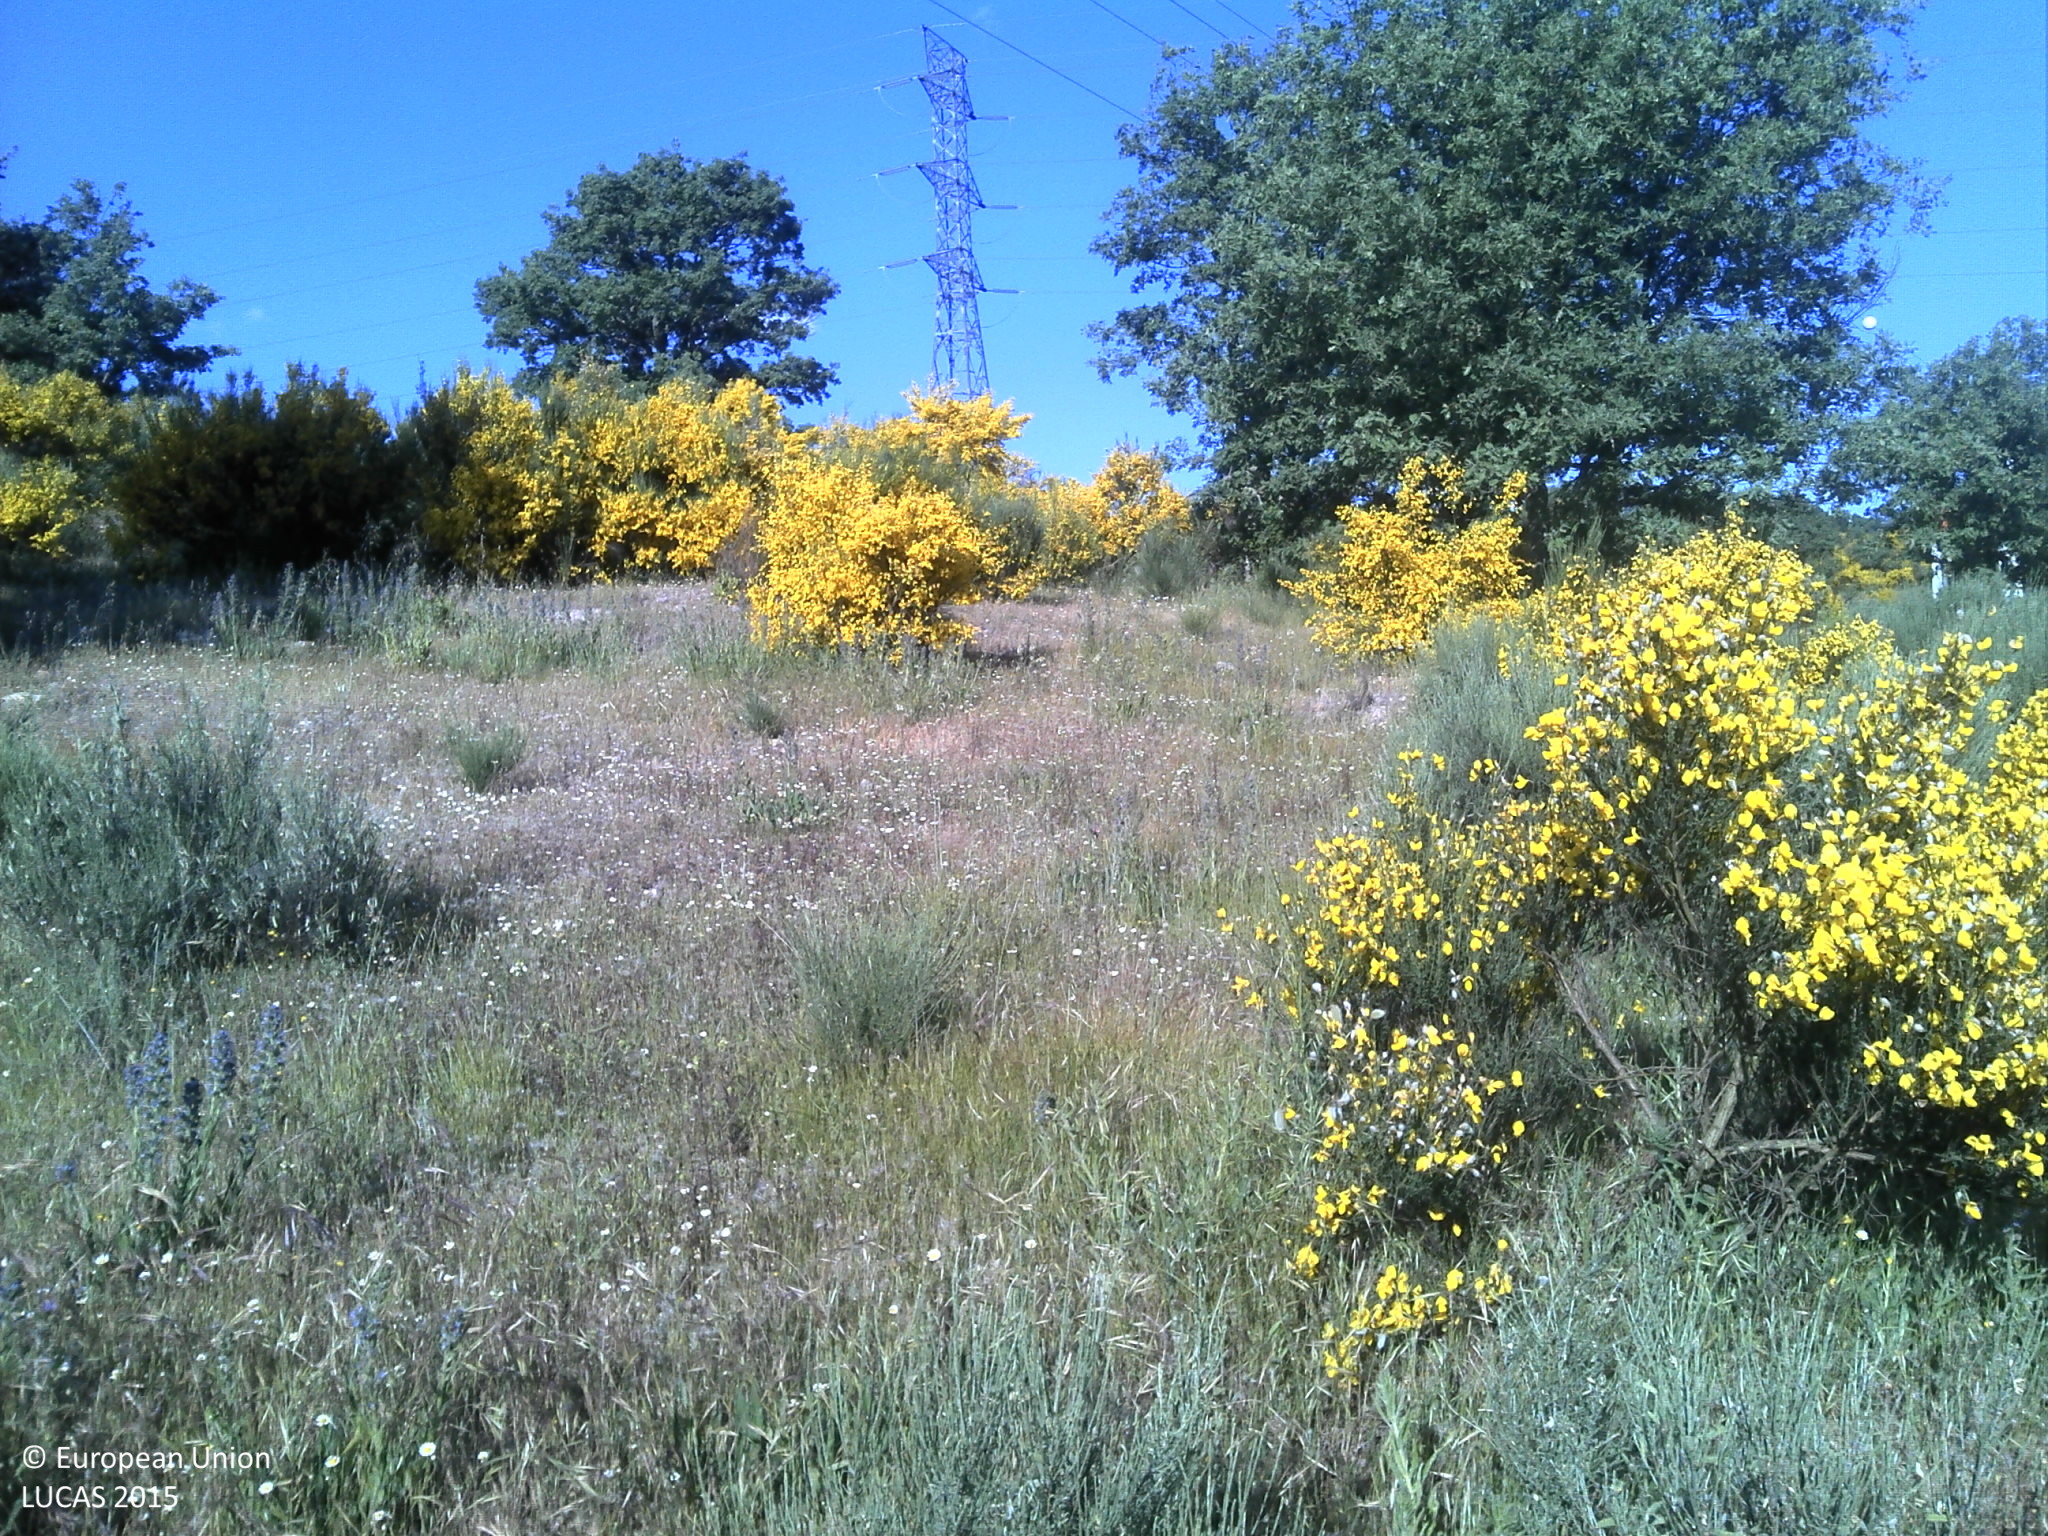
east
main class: Grassland
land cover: Grassland with sparse tree/shrub cover
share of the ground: 50 - 75 %
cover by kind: herbaceous plants 70 %, shrubs 10 %, unconsolidated bare surface 10 %, broadleaved forest trees 5 %
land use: Agriculture (excluding fallow land and kitchen gardens)
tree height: > 5 m
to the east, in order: Grassland with sparse tree/shrub cover; Shrubland with sparse tree cover; Electric lines; Fences; Shrubland without tree cover; Grass margins; Paved roads, cycling and walking lanes; Grass margins; Spontaneously vegetated surfaces; Fences; Grass margins; Tracks; Grass margins; Grassland without tree/shrub cover; Electric lines; Grassland without tree/shrub cover; Shrubland without tree cover; Abandoned hedges; Shrubland without tree cover
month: May
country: PT
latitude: 40.5582
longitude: -7.2177
